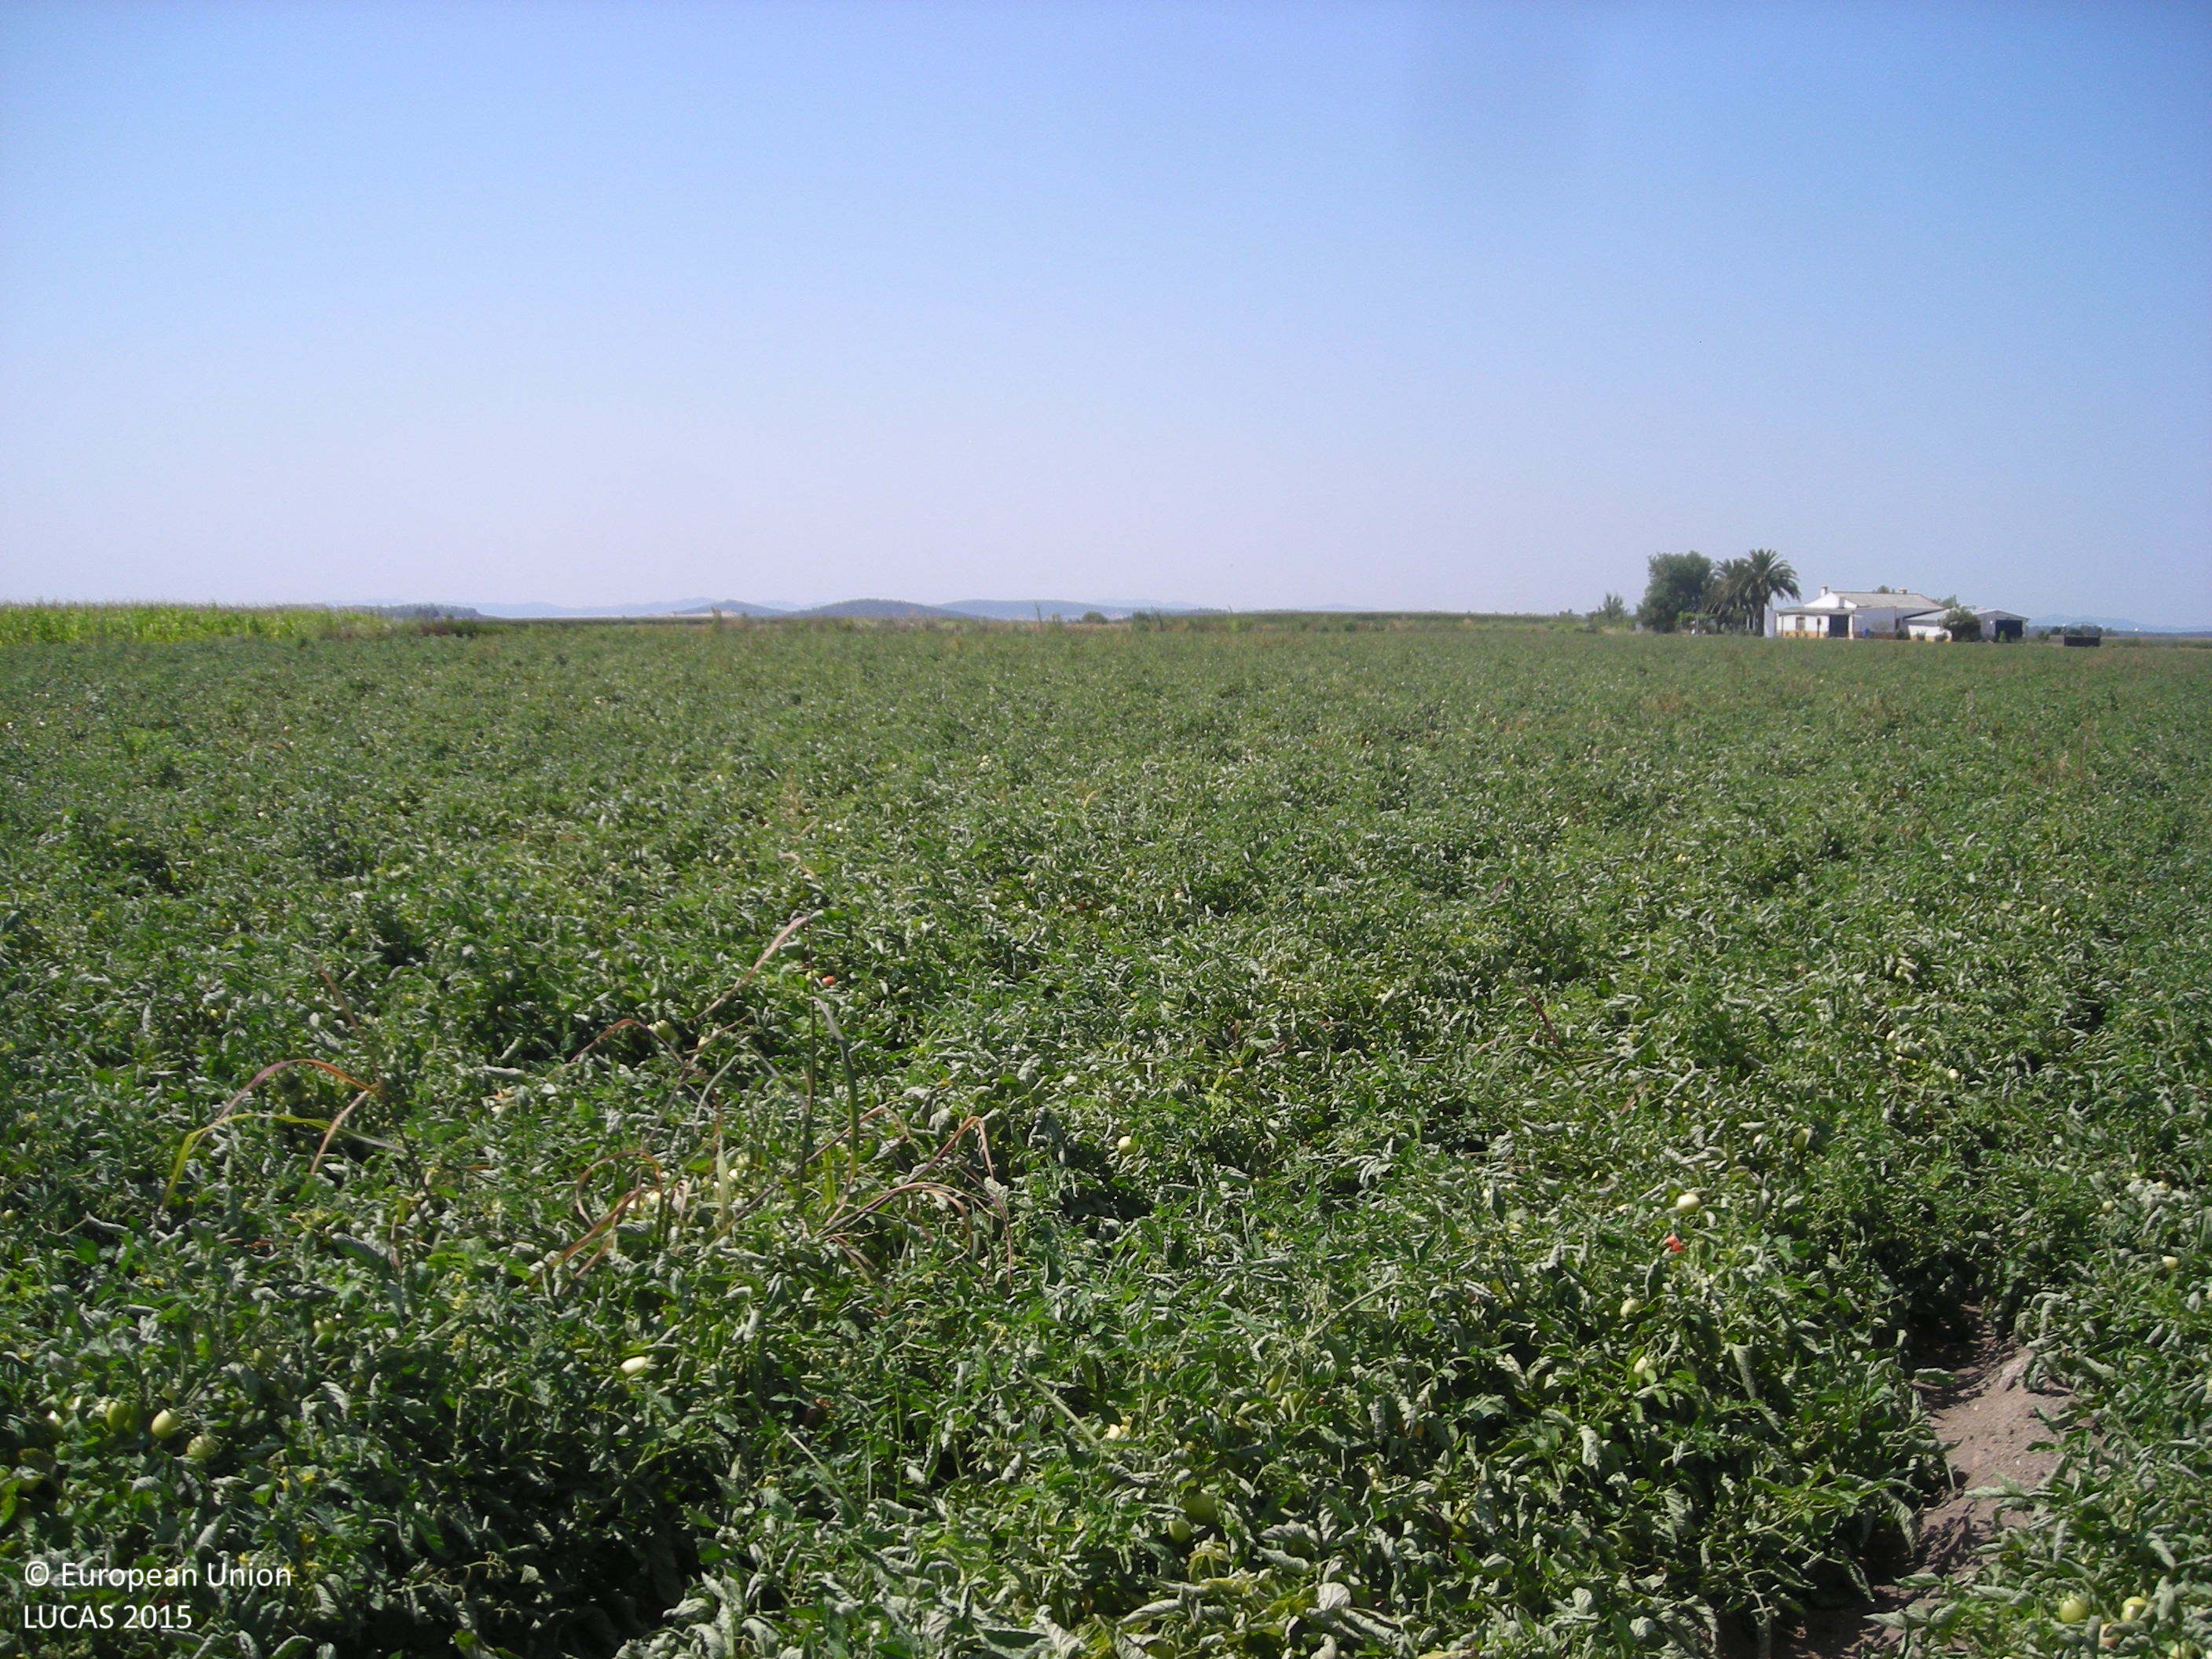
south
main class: Cropland
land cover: Tomatoes
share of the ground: > 75 %
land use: Agriculture (excluding fallow land and kitchen gardens)
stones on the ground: < 10 %
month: July
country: ES
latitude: 39.0923
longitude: -5.9978
